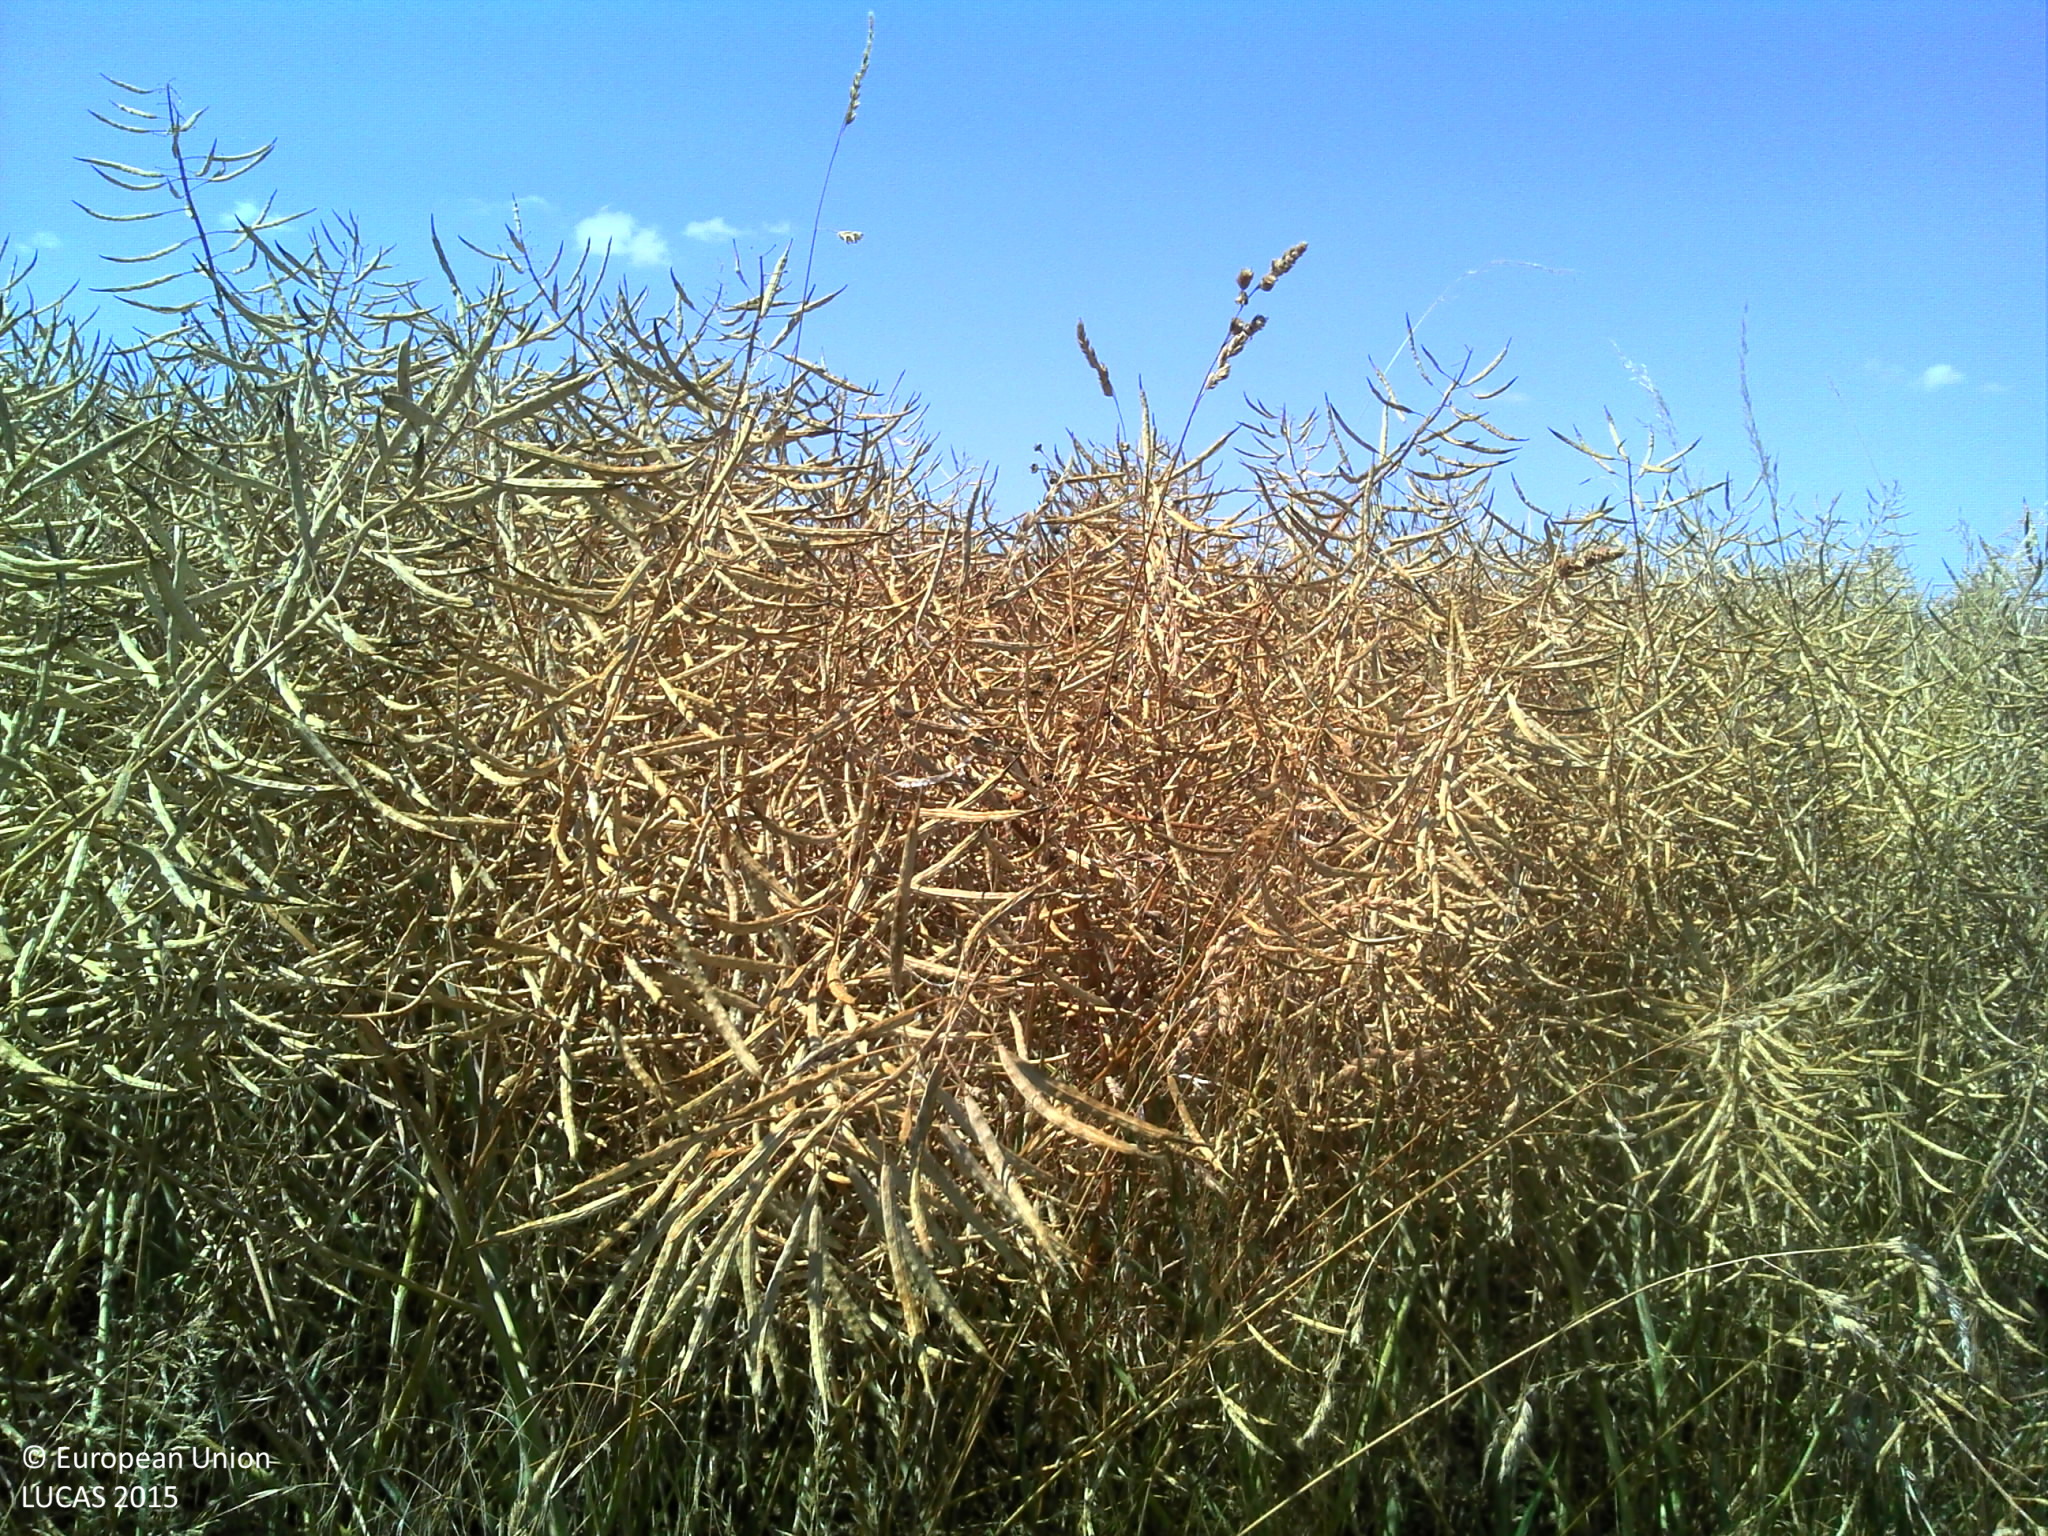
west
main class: Cropland
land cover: Rape and turnip rape
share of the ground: > 75 %
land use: Agriculture (excluding fallow land and kitchen gardens)
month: July
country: FR
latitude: 47.9184
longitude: 0.6783
